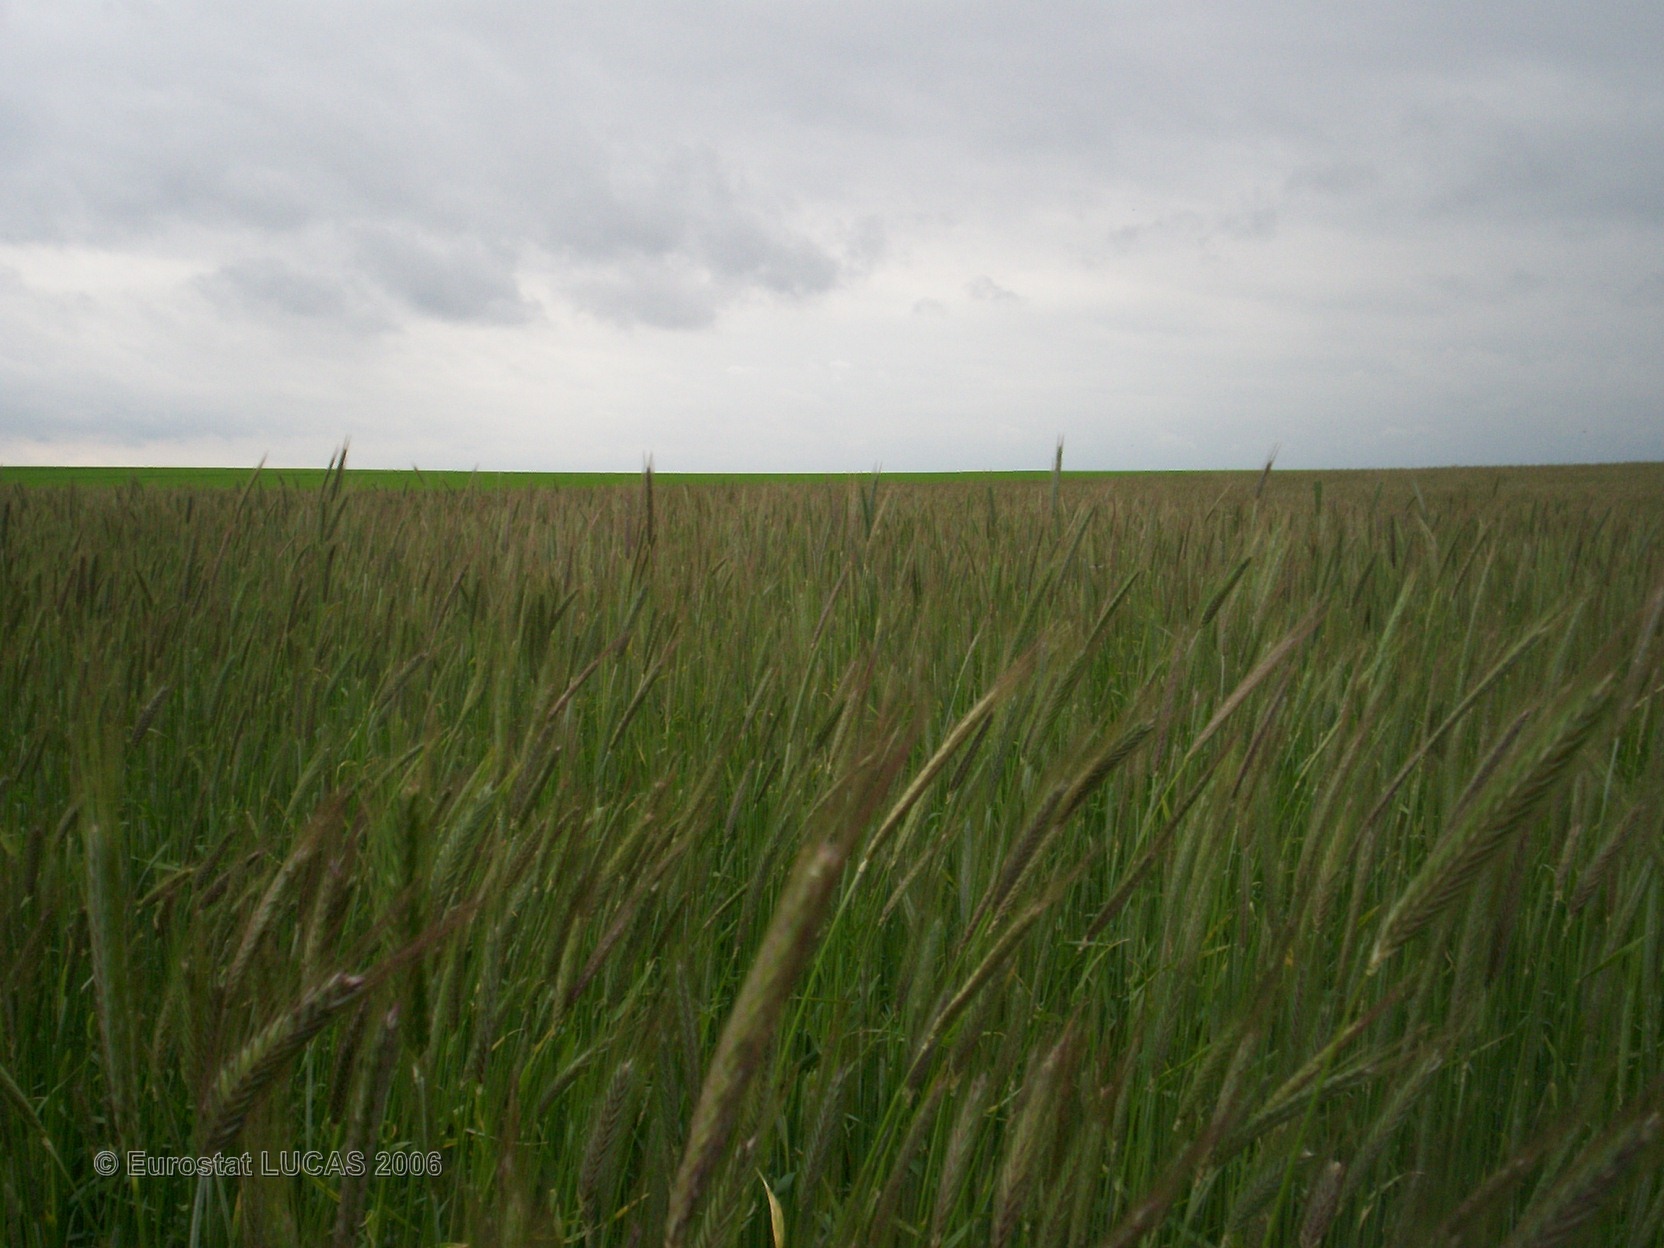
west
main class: Cropland
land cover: Rye
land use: Agriculture (excluding fallow land and kitchen gardens)
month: May
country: FR
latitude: 49.3405
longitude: 4.3392
